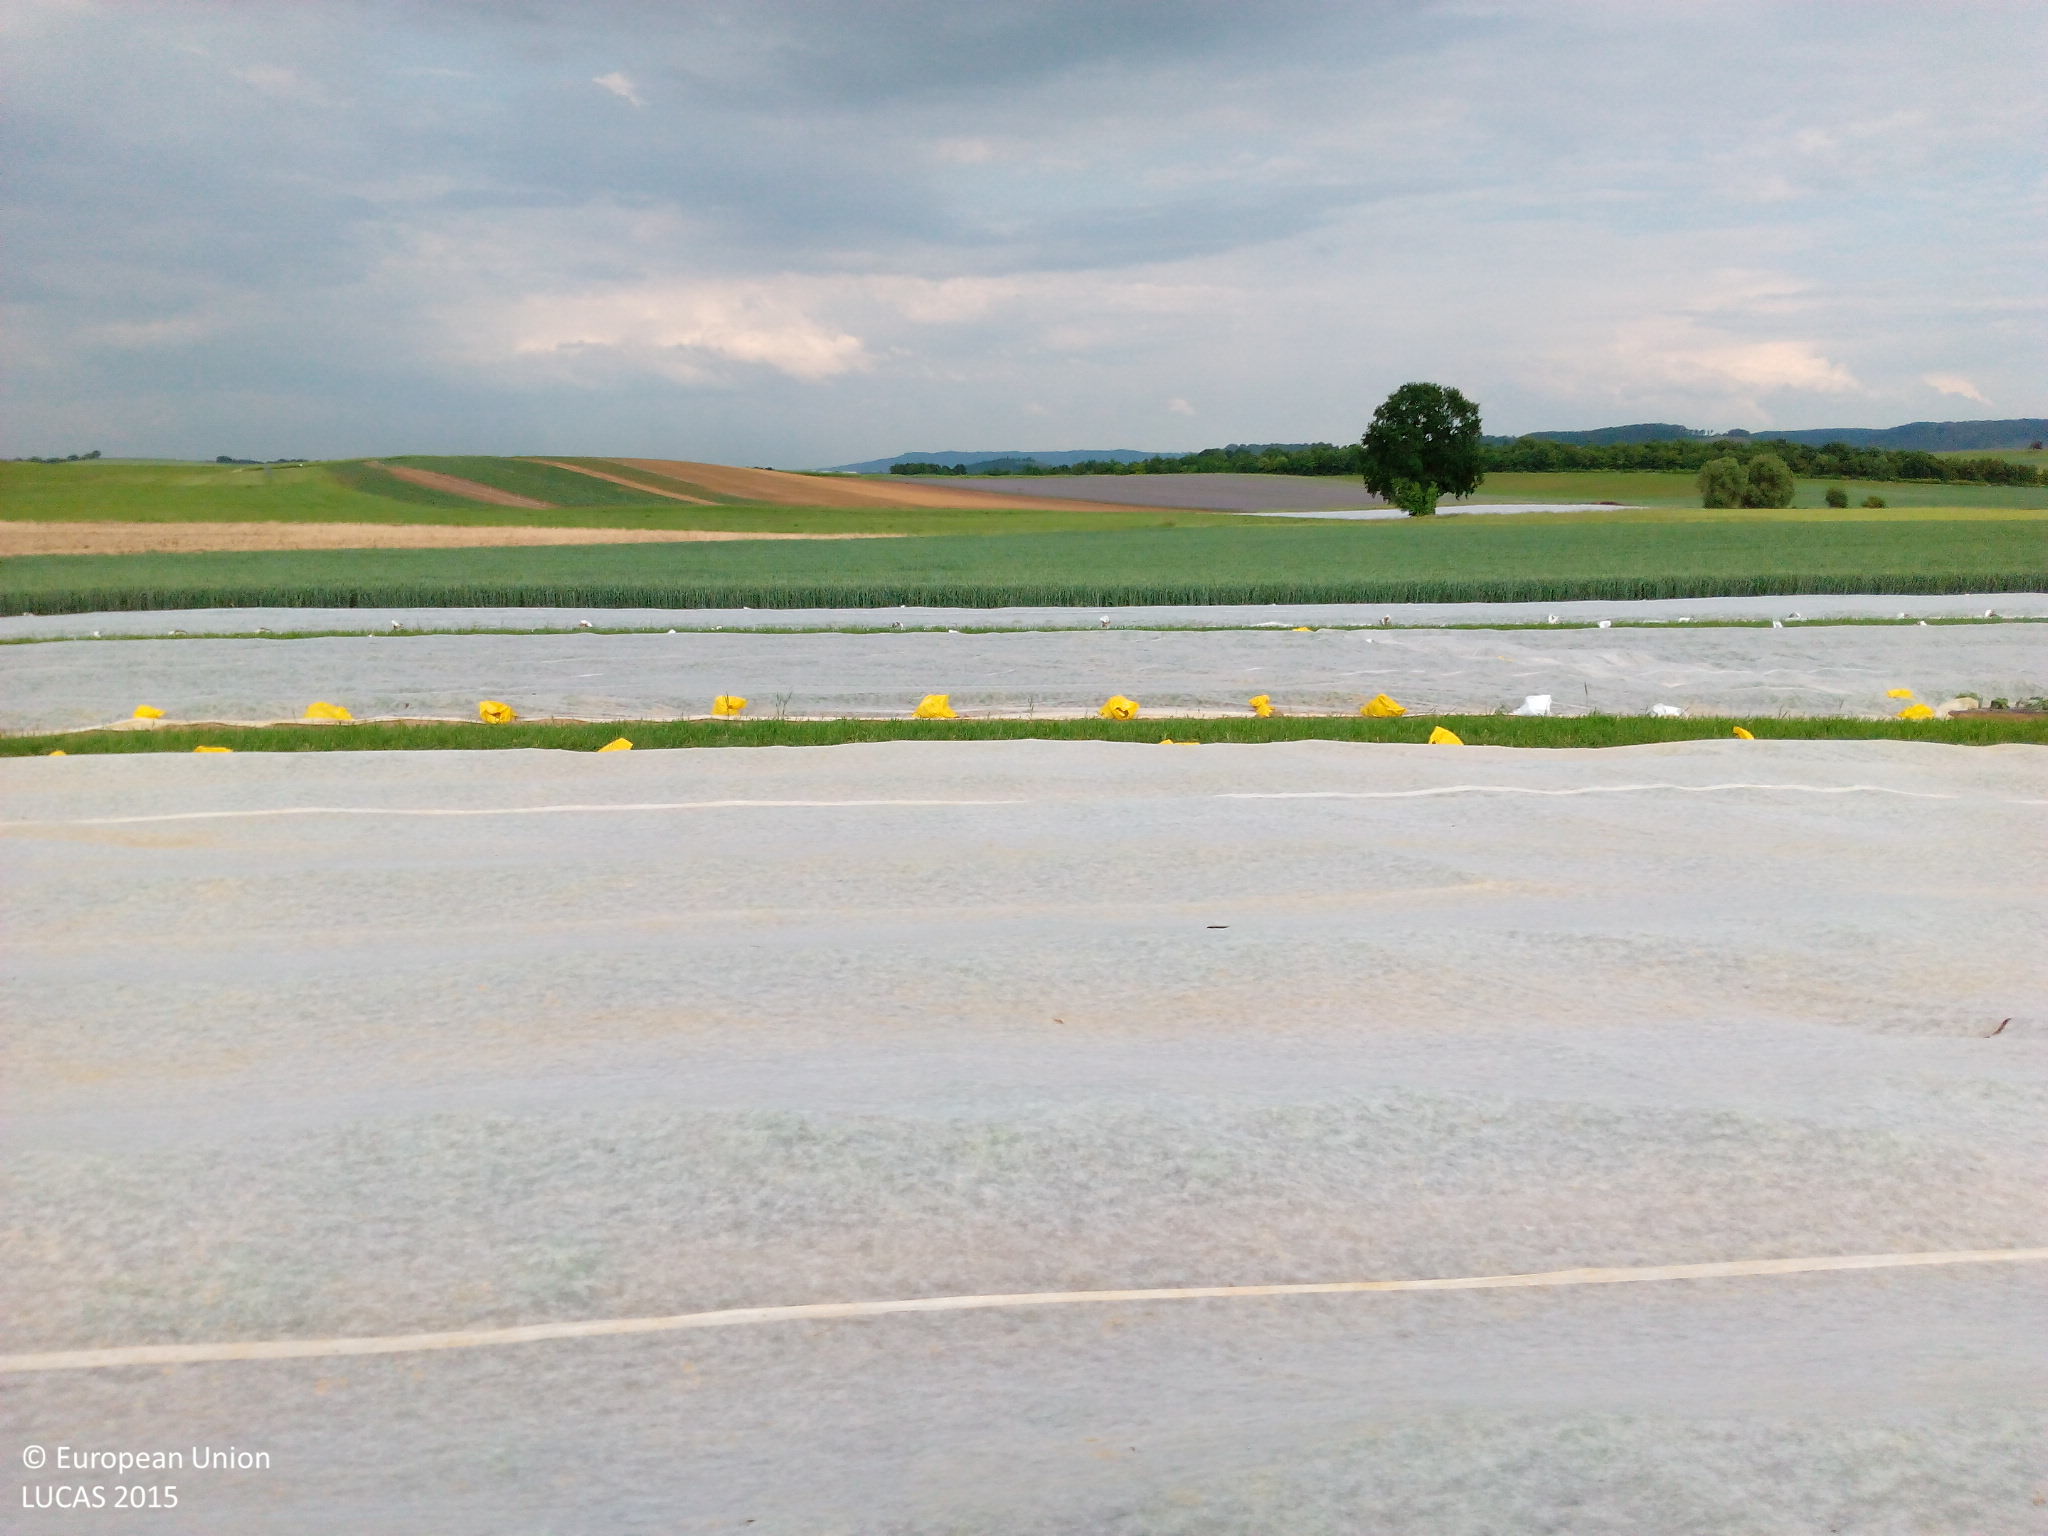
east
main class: Cropland
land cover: Other fresh vegetables
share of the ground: 10 - 25 %
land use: Agriculture (excluding fallow land and kitchen gardens)
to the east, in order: Other fresh vegetables; Grass margins; Other fresh vegetables; Grass margins; Other fresh vegetables; Common wheat; Tracks; Grass margins; Rivers and streams; Other bare soil; Grass margins; Ditches and canals; Grassland without tree/shrub cover; Other fresh vegetables
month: May
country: DE
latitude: 49.1935
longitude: 9.4102
